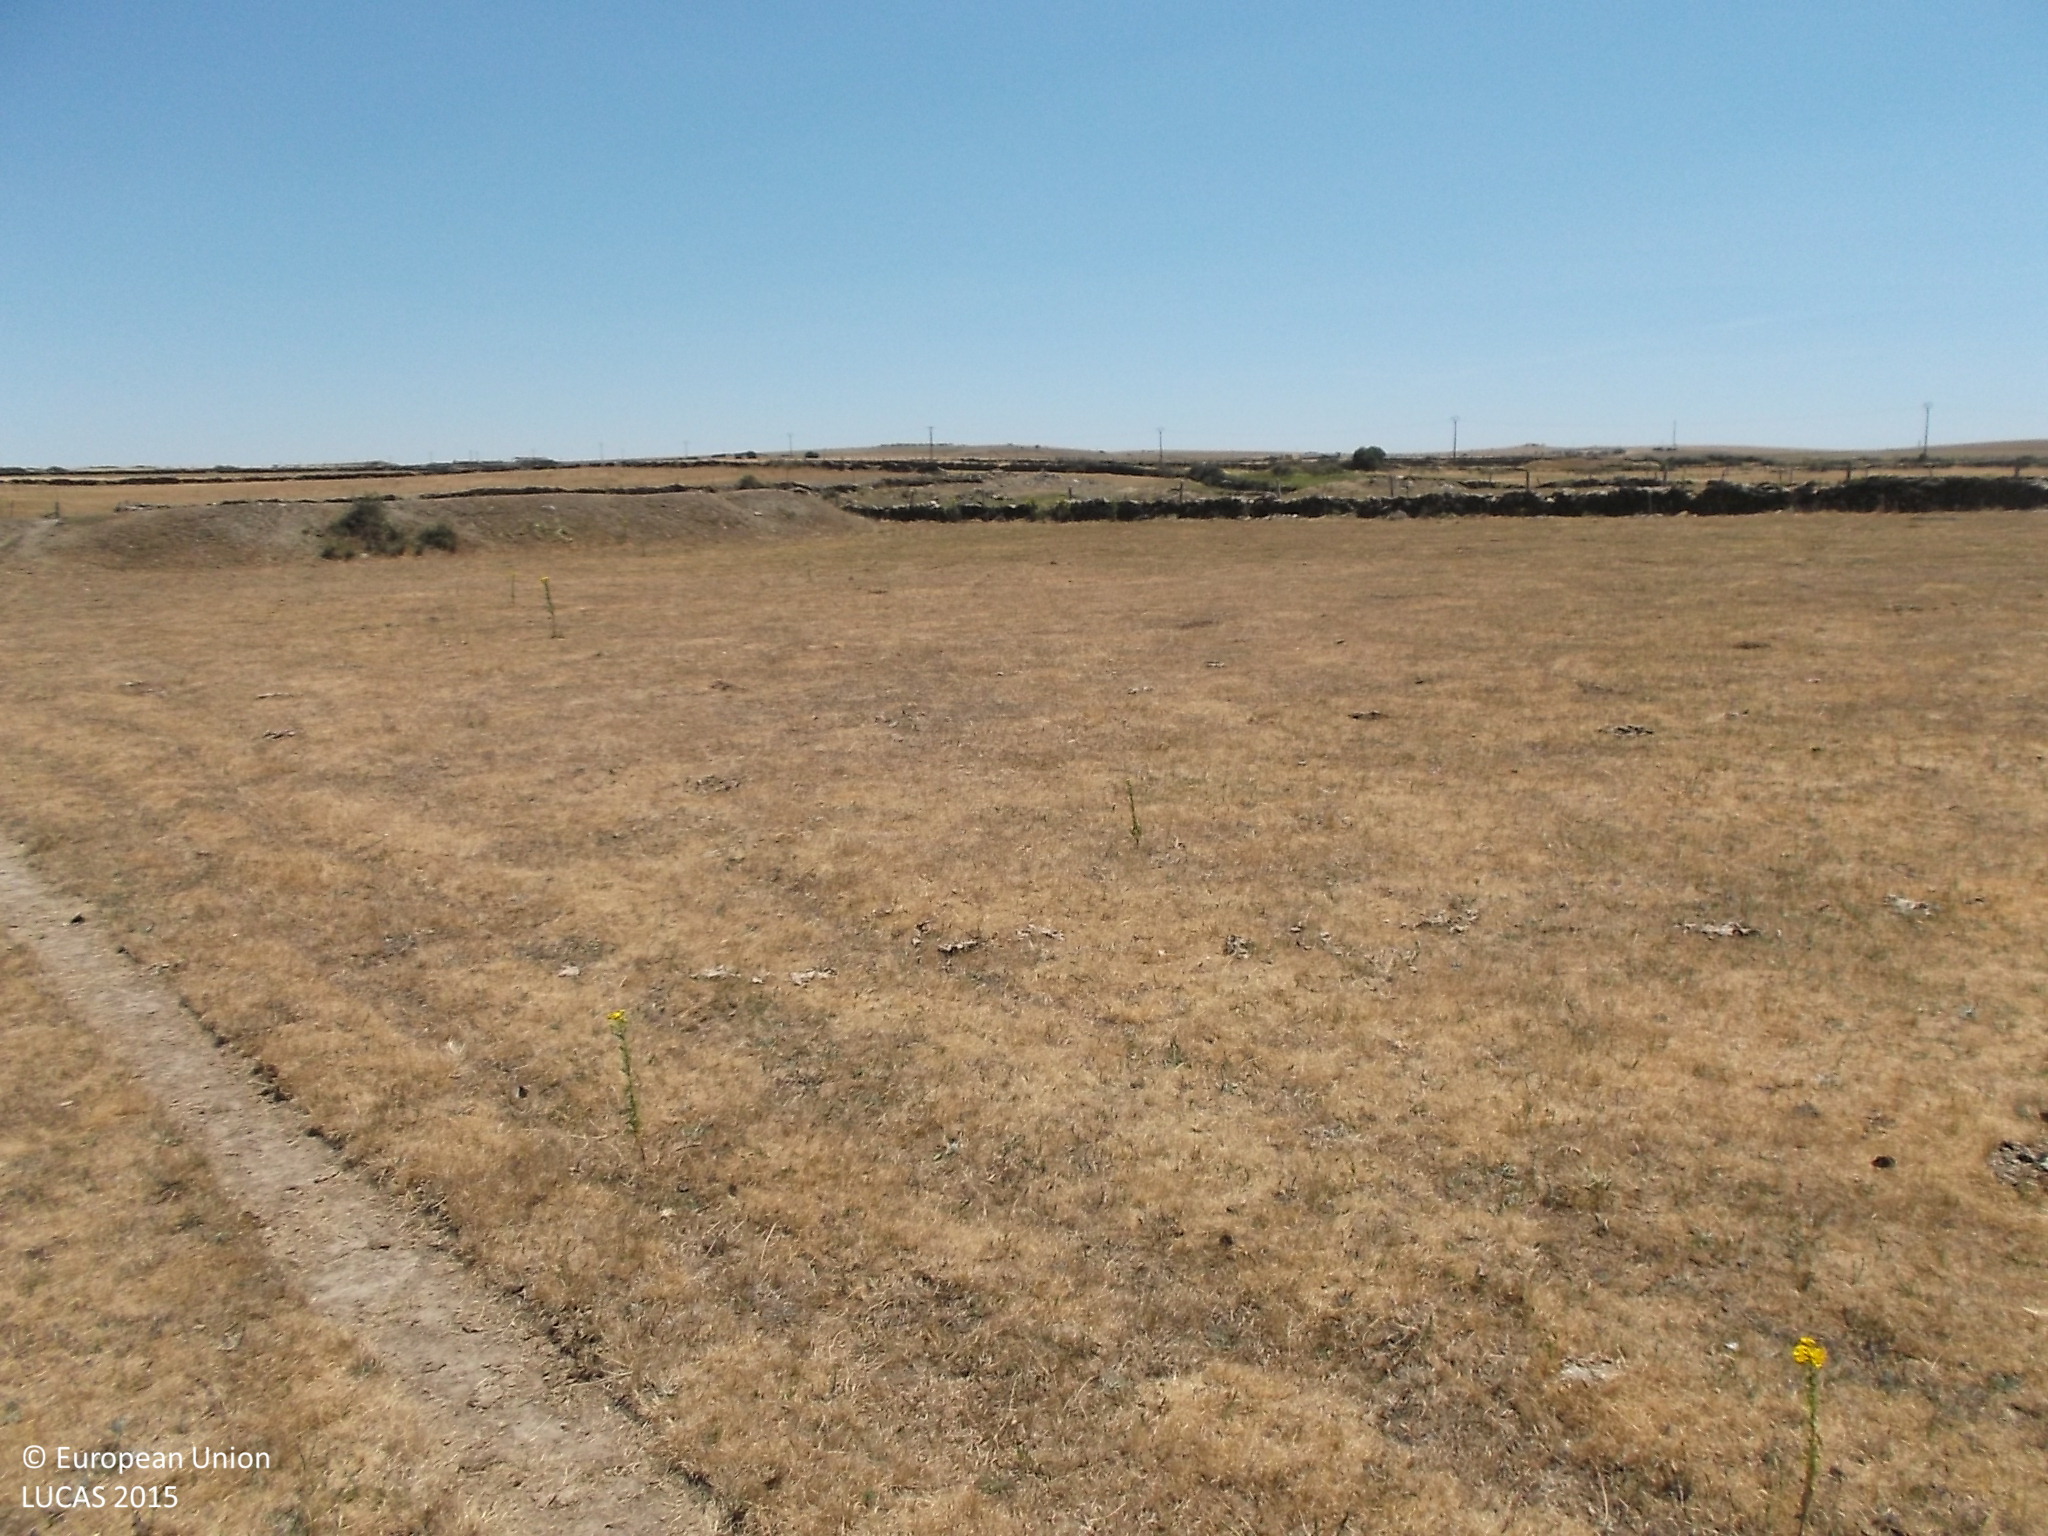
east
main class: Grassland
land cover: Grassland without tree/shrub cover
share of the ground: > 75 %
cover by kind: herbaceous plants 100 %
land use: Agriculture (excluding fallow land and kitchen gardens)
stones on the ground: < 10 %
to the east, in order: Grassland without tree/shrub cover; Fences; Grassland without tree/shrub cover; Dry stone walls; Grassland without tree/shrub cover; Fences; Grassland without tree/shrub cover; Fences; Dry stone walls; Grassland without tree/shrub cover
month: July
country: ES
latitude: 40.7172
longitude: -6.7285
